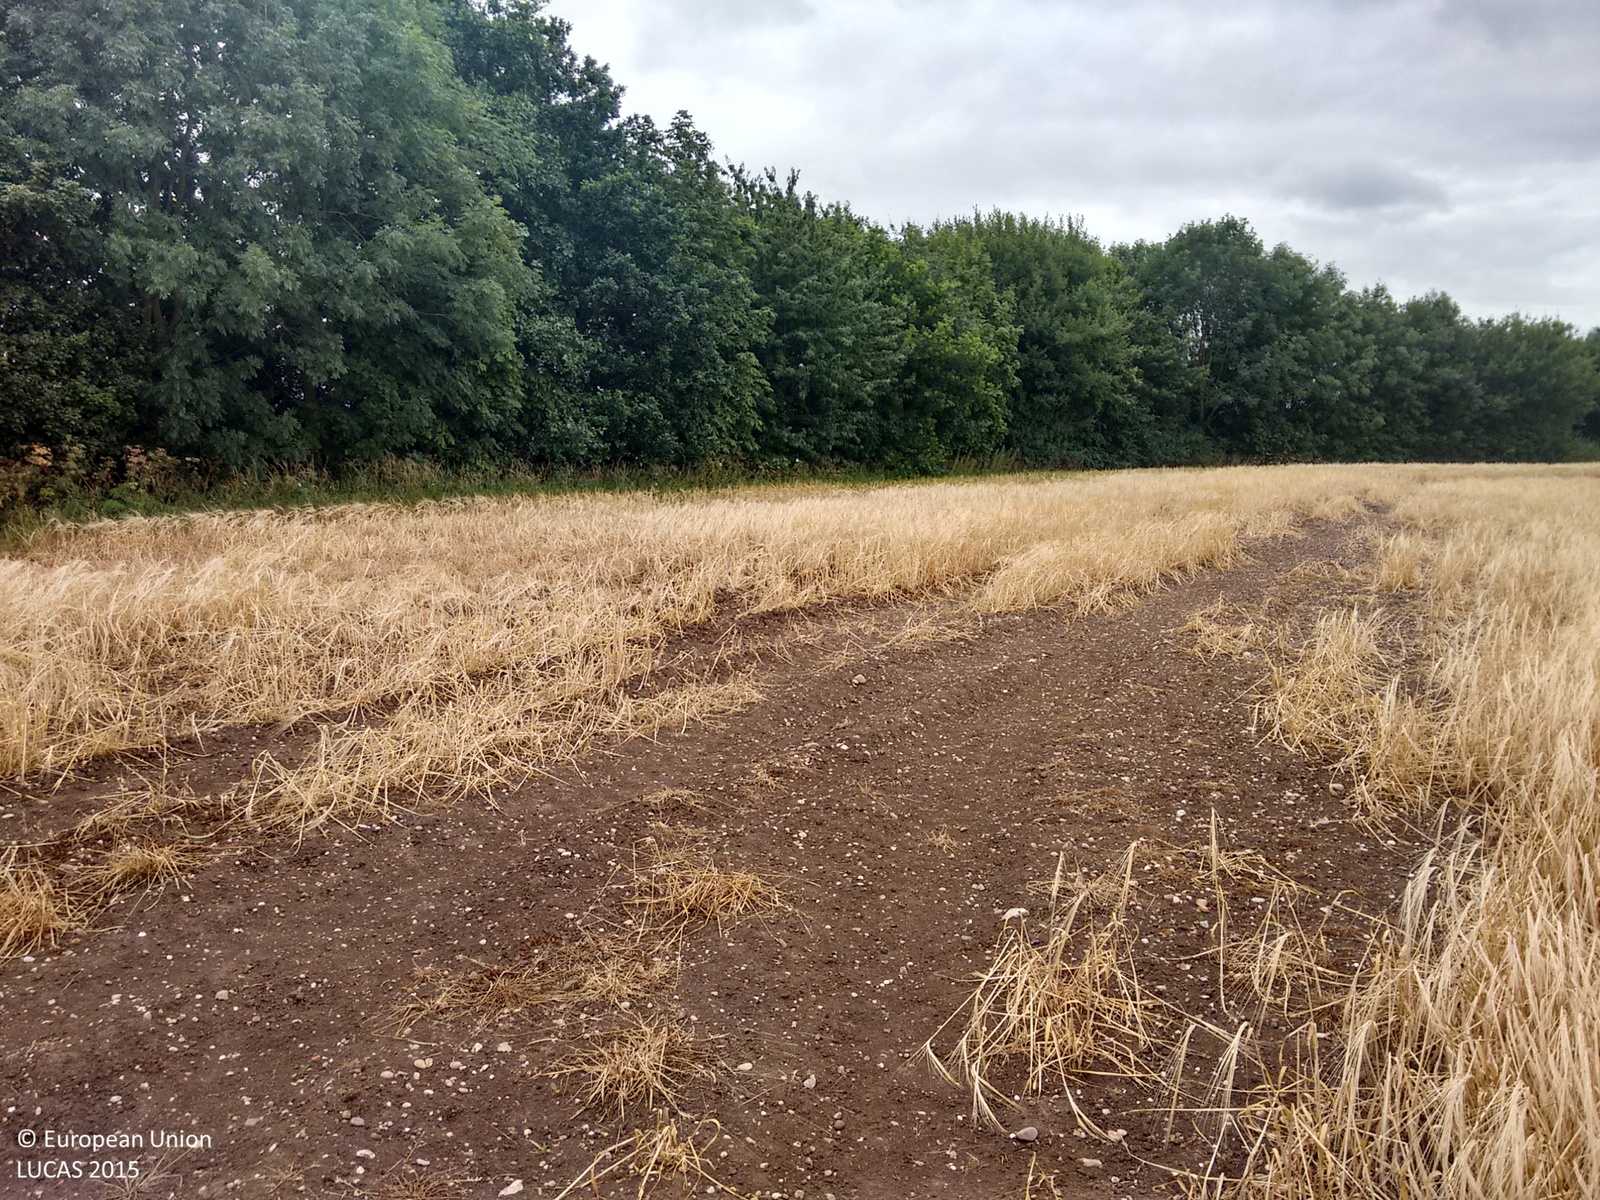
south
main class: Cropland
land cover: Barley
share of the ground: > 75 %
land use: Agriculture (excluding fallow land and kitchen gardens)
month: July
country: GB
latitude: 52.8781
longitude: -1.4165
